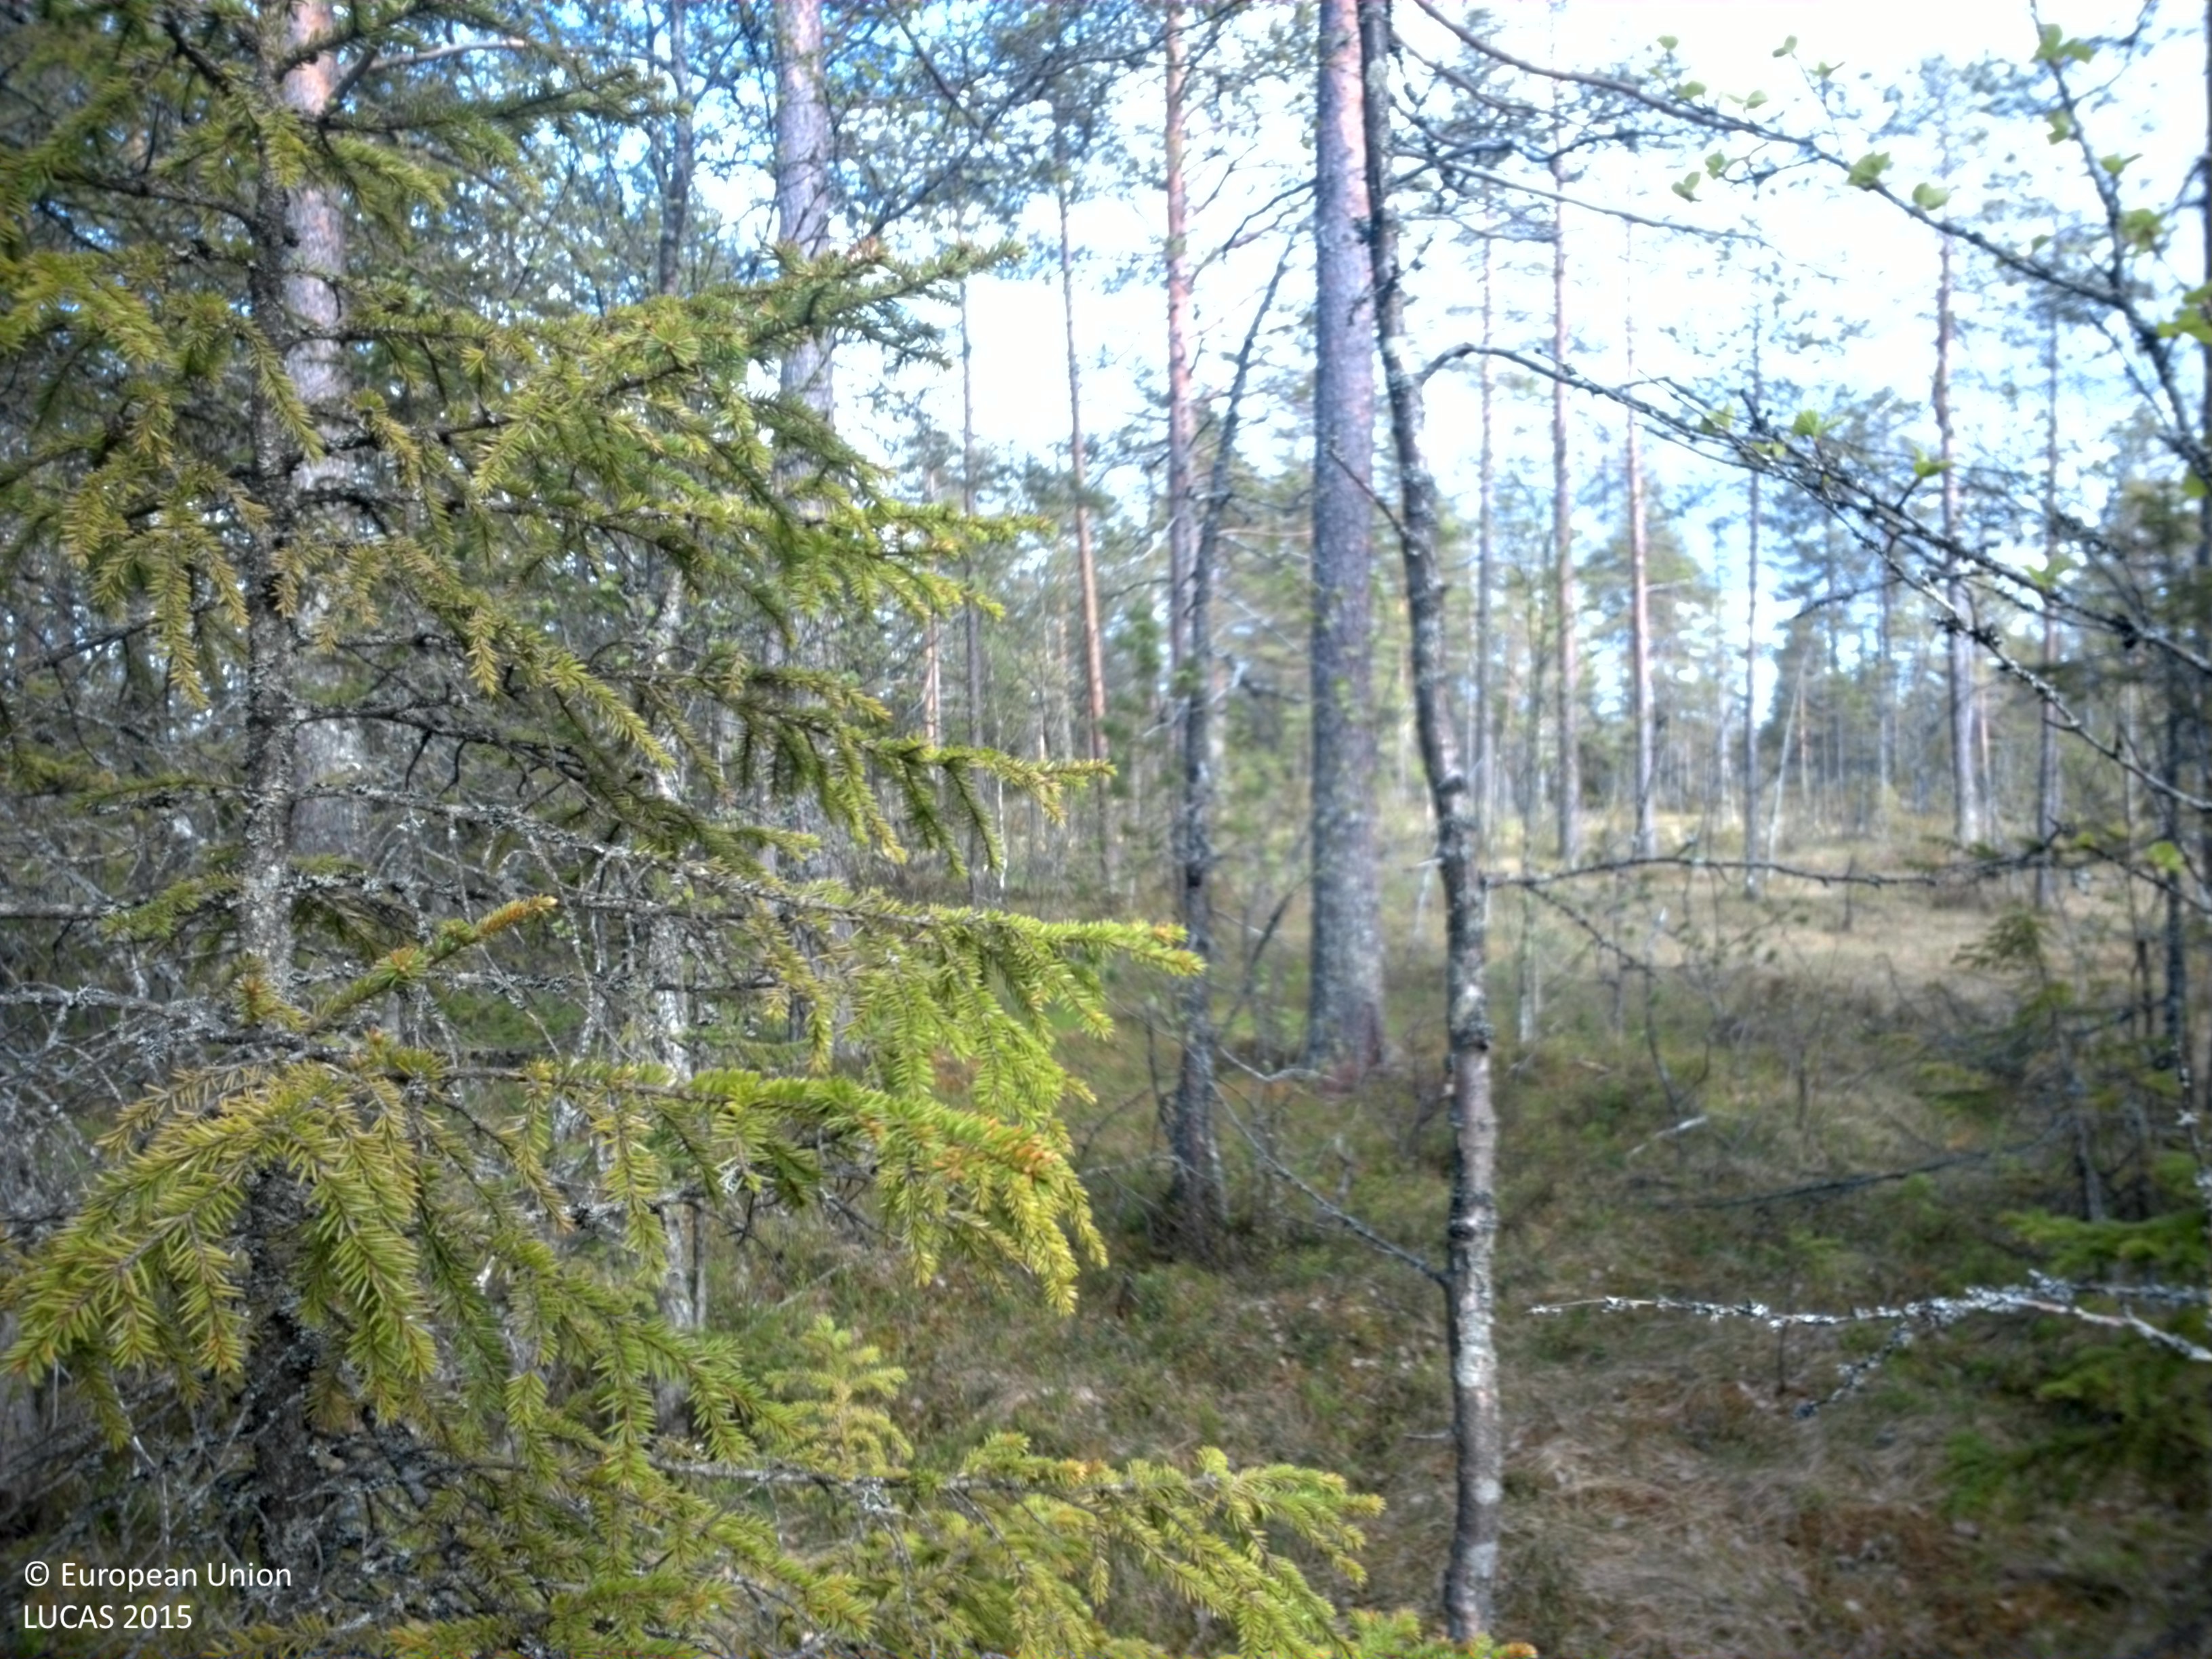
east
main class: Woodland
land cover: Spruce dominated coniferous woodland
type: boreal forest
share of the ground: 50 - 75 %
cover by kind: coniferous forest trees 45 %, shrubs 20 %, lichens and mosses 20 %, broadleaved forest trees 15 %
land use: Semi-natural and natural areas not in use
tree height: > 5 m
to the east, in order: Spruce dominated coniferous woodland; Pine dominated coniferous woodland; Peatbogs; Pine dominated coniferous woodland
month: June
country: SE
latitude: 61.1527
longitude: 13.2403
